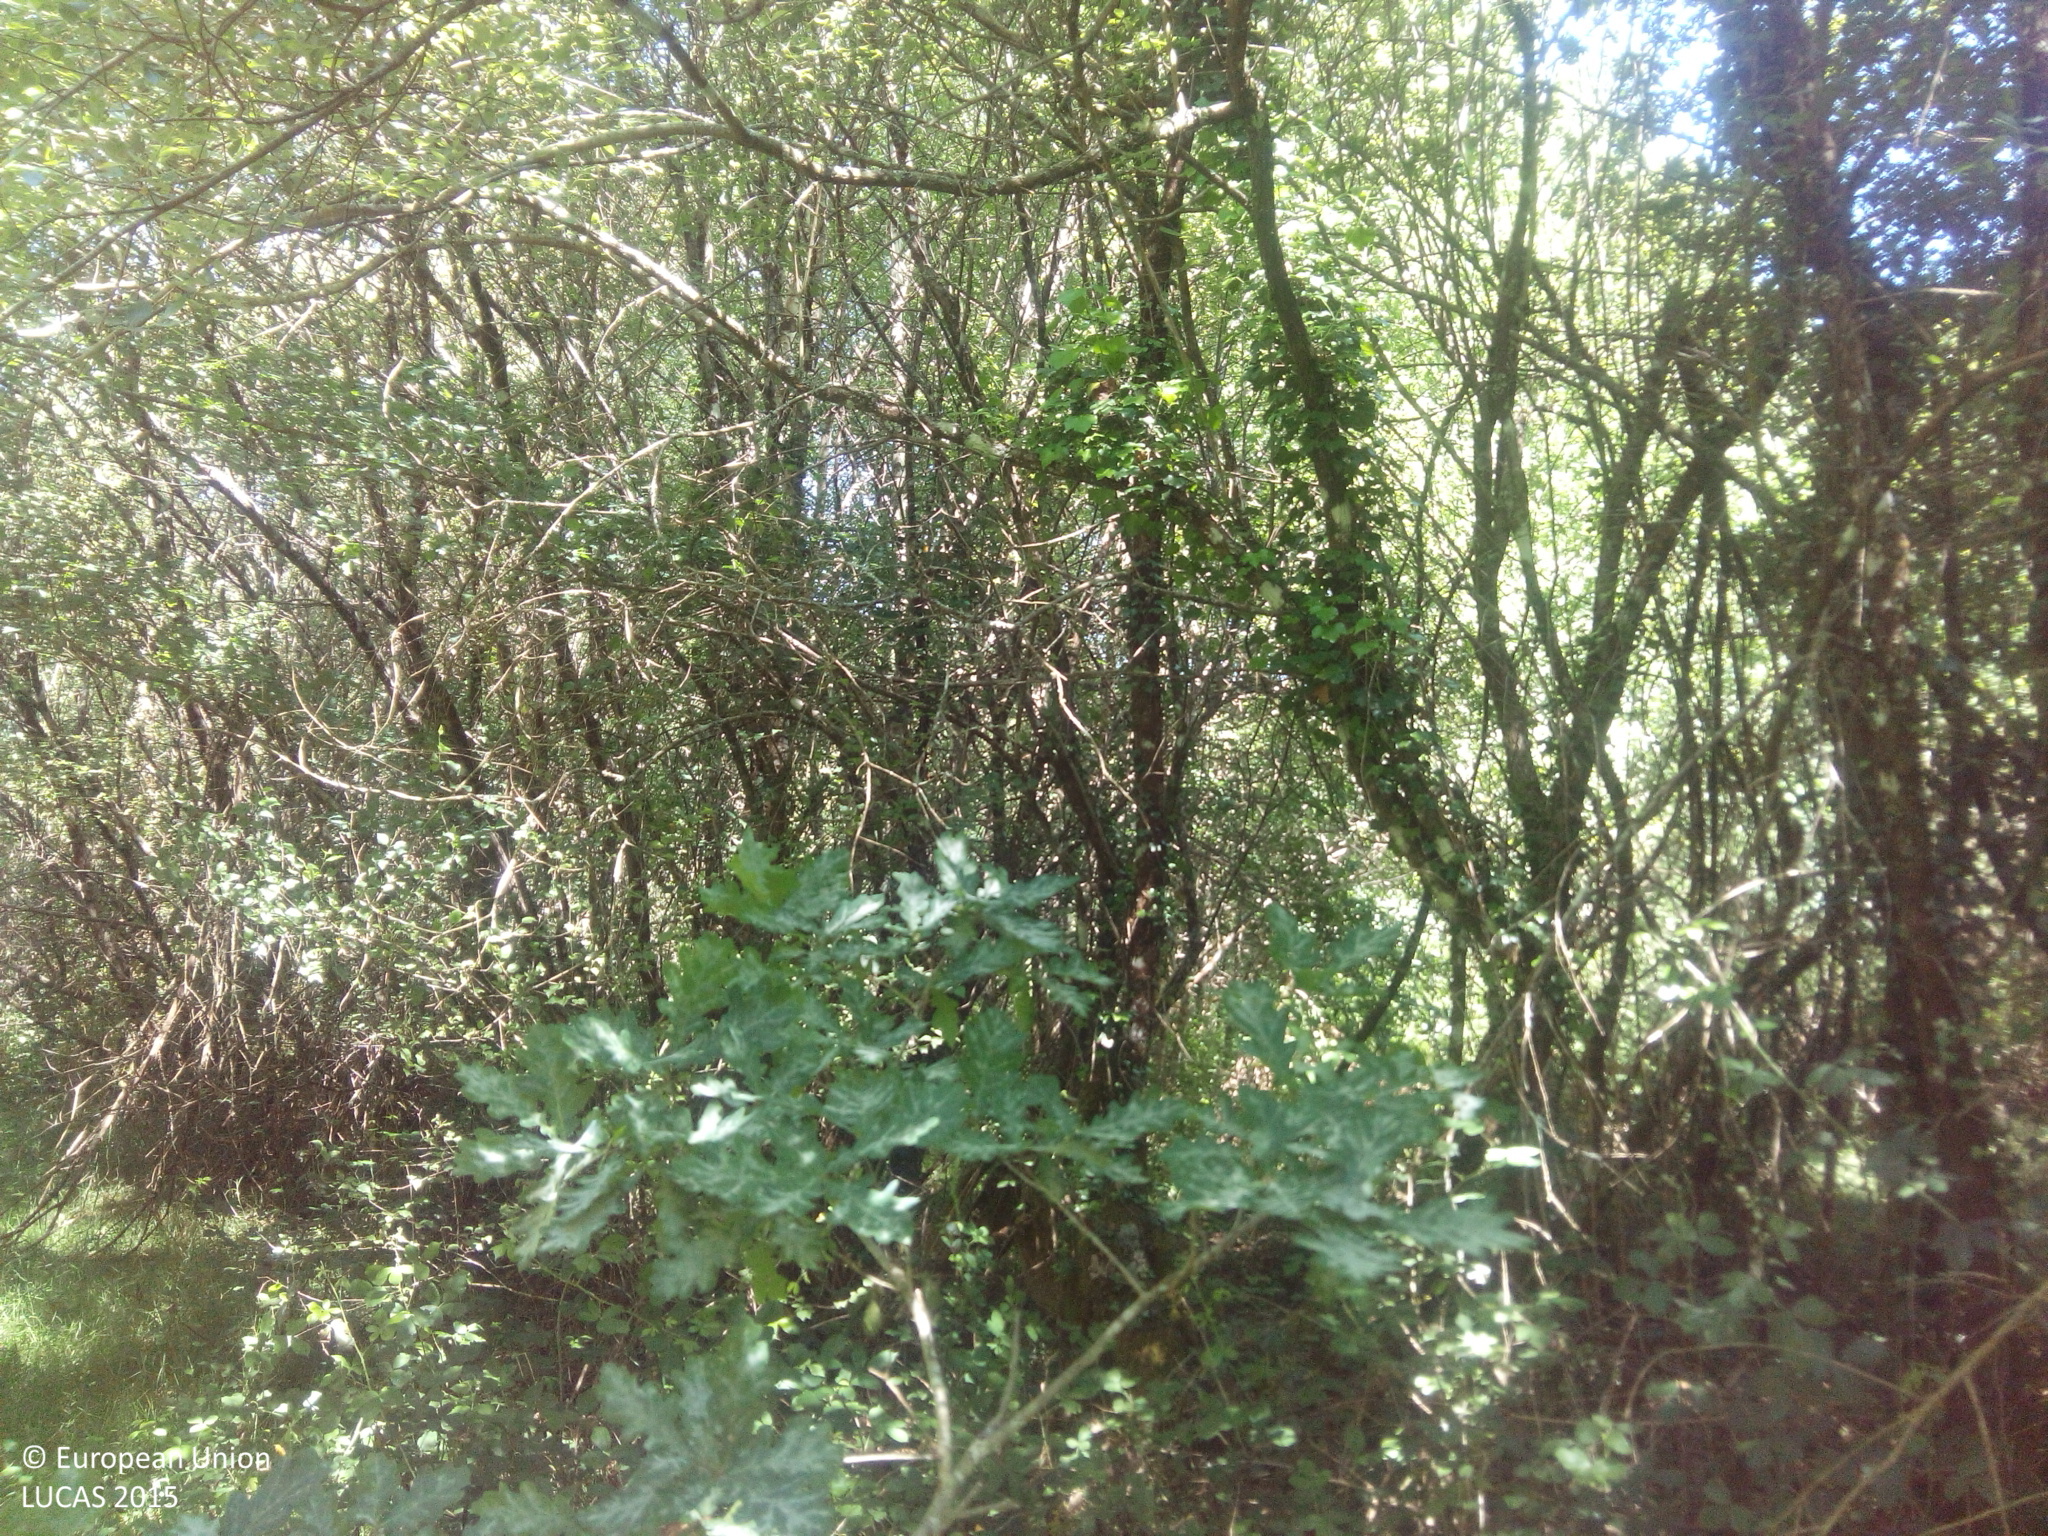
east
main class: Woodland
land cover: Broadleaved woodland
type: acidophilous oak and oak-birch forest
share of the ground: > 75 %
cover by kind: broadleaved forest trees 100 %
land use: Forestry
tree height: > 5 m
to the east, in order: Broadleaved woodland; Dry stone walls; Broadleaved woodland; Rivers and streams; Broadleaved woodland; Grassland without tree/shrub cover
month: June
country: ES
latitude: 42.4793
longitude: -8.3272
